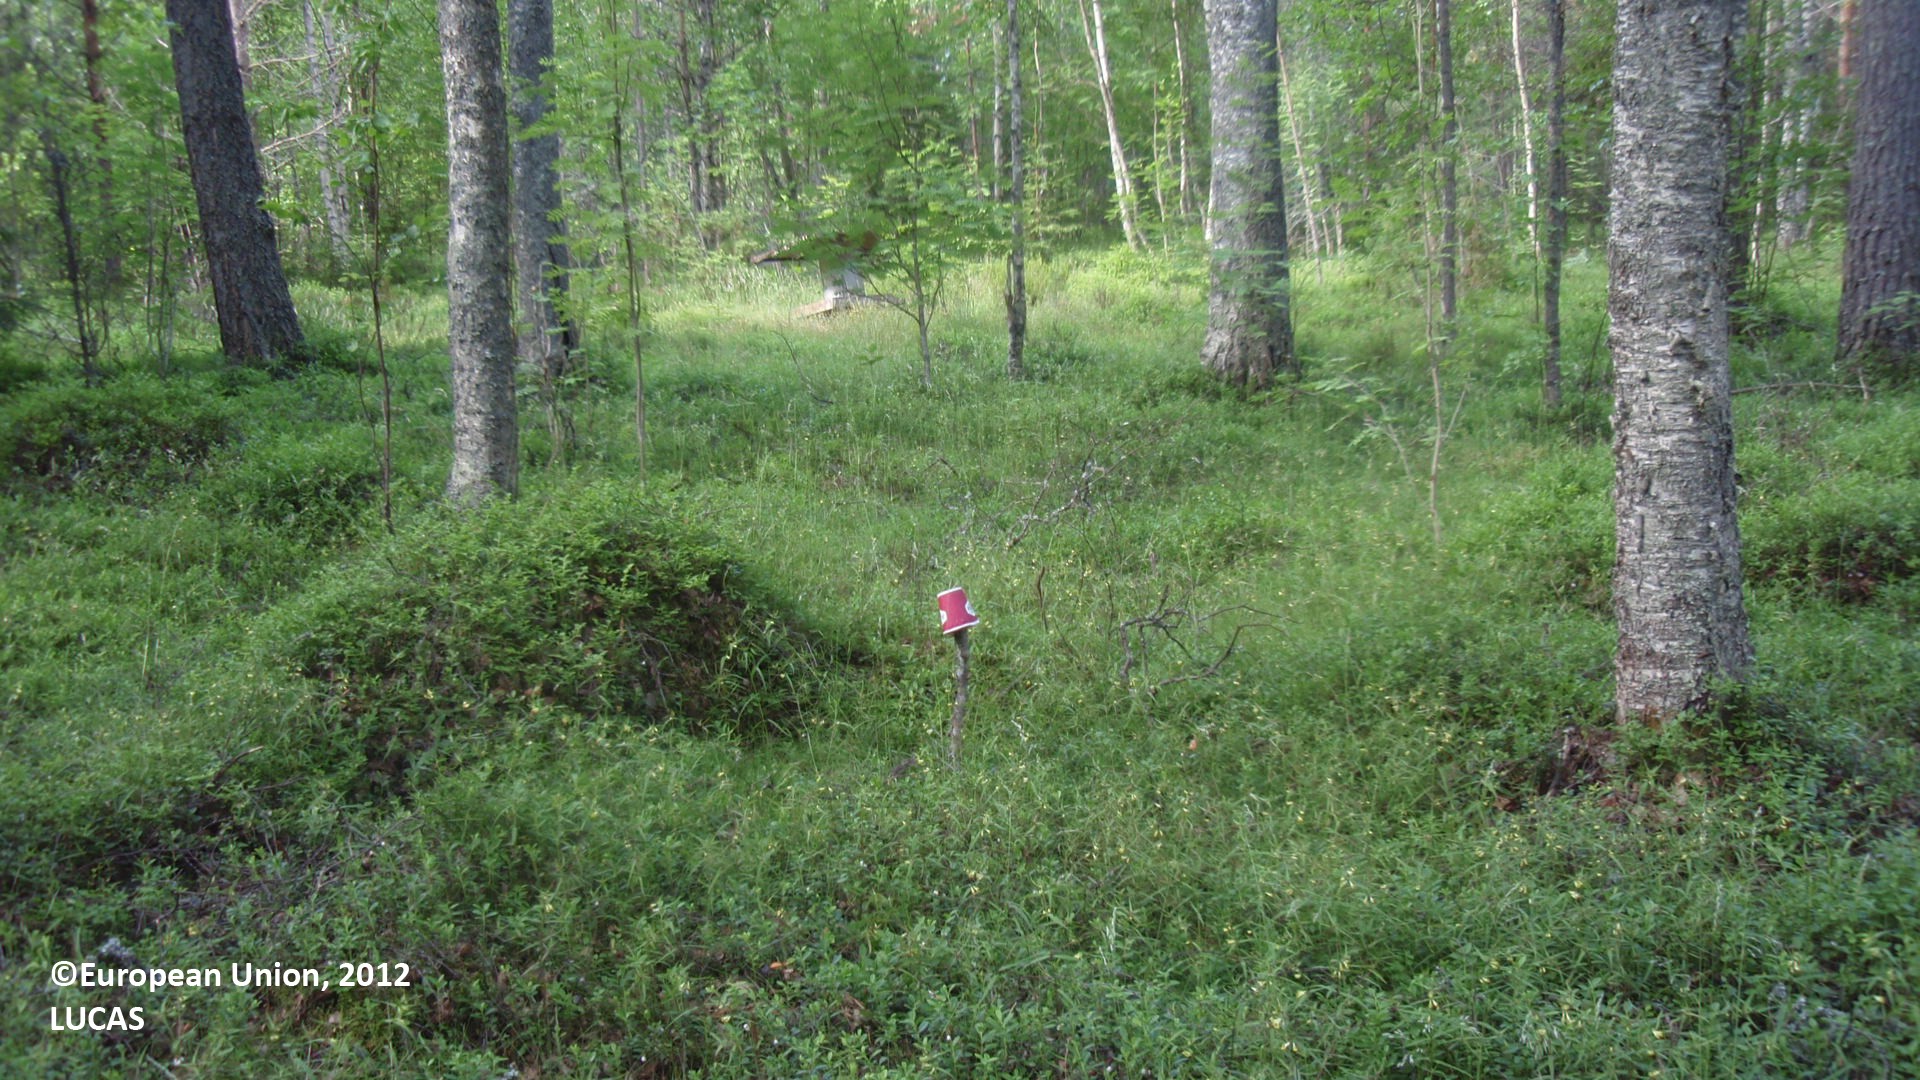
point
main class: Woodland
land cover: Pine dominated mixed woodland
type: boreal forest
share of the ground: 25 - 50 %
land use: Forestry
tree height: > 5 m
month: July
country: FI
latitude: 61.6728
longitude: 28.2032
